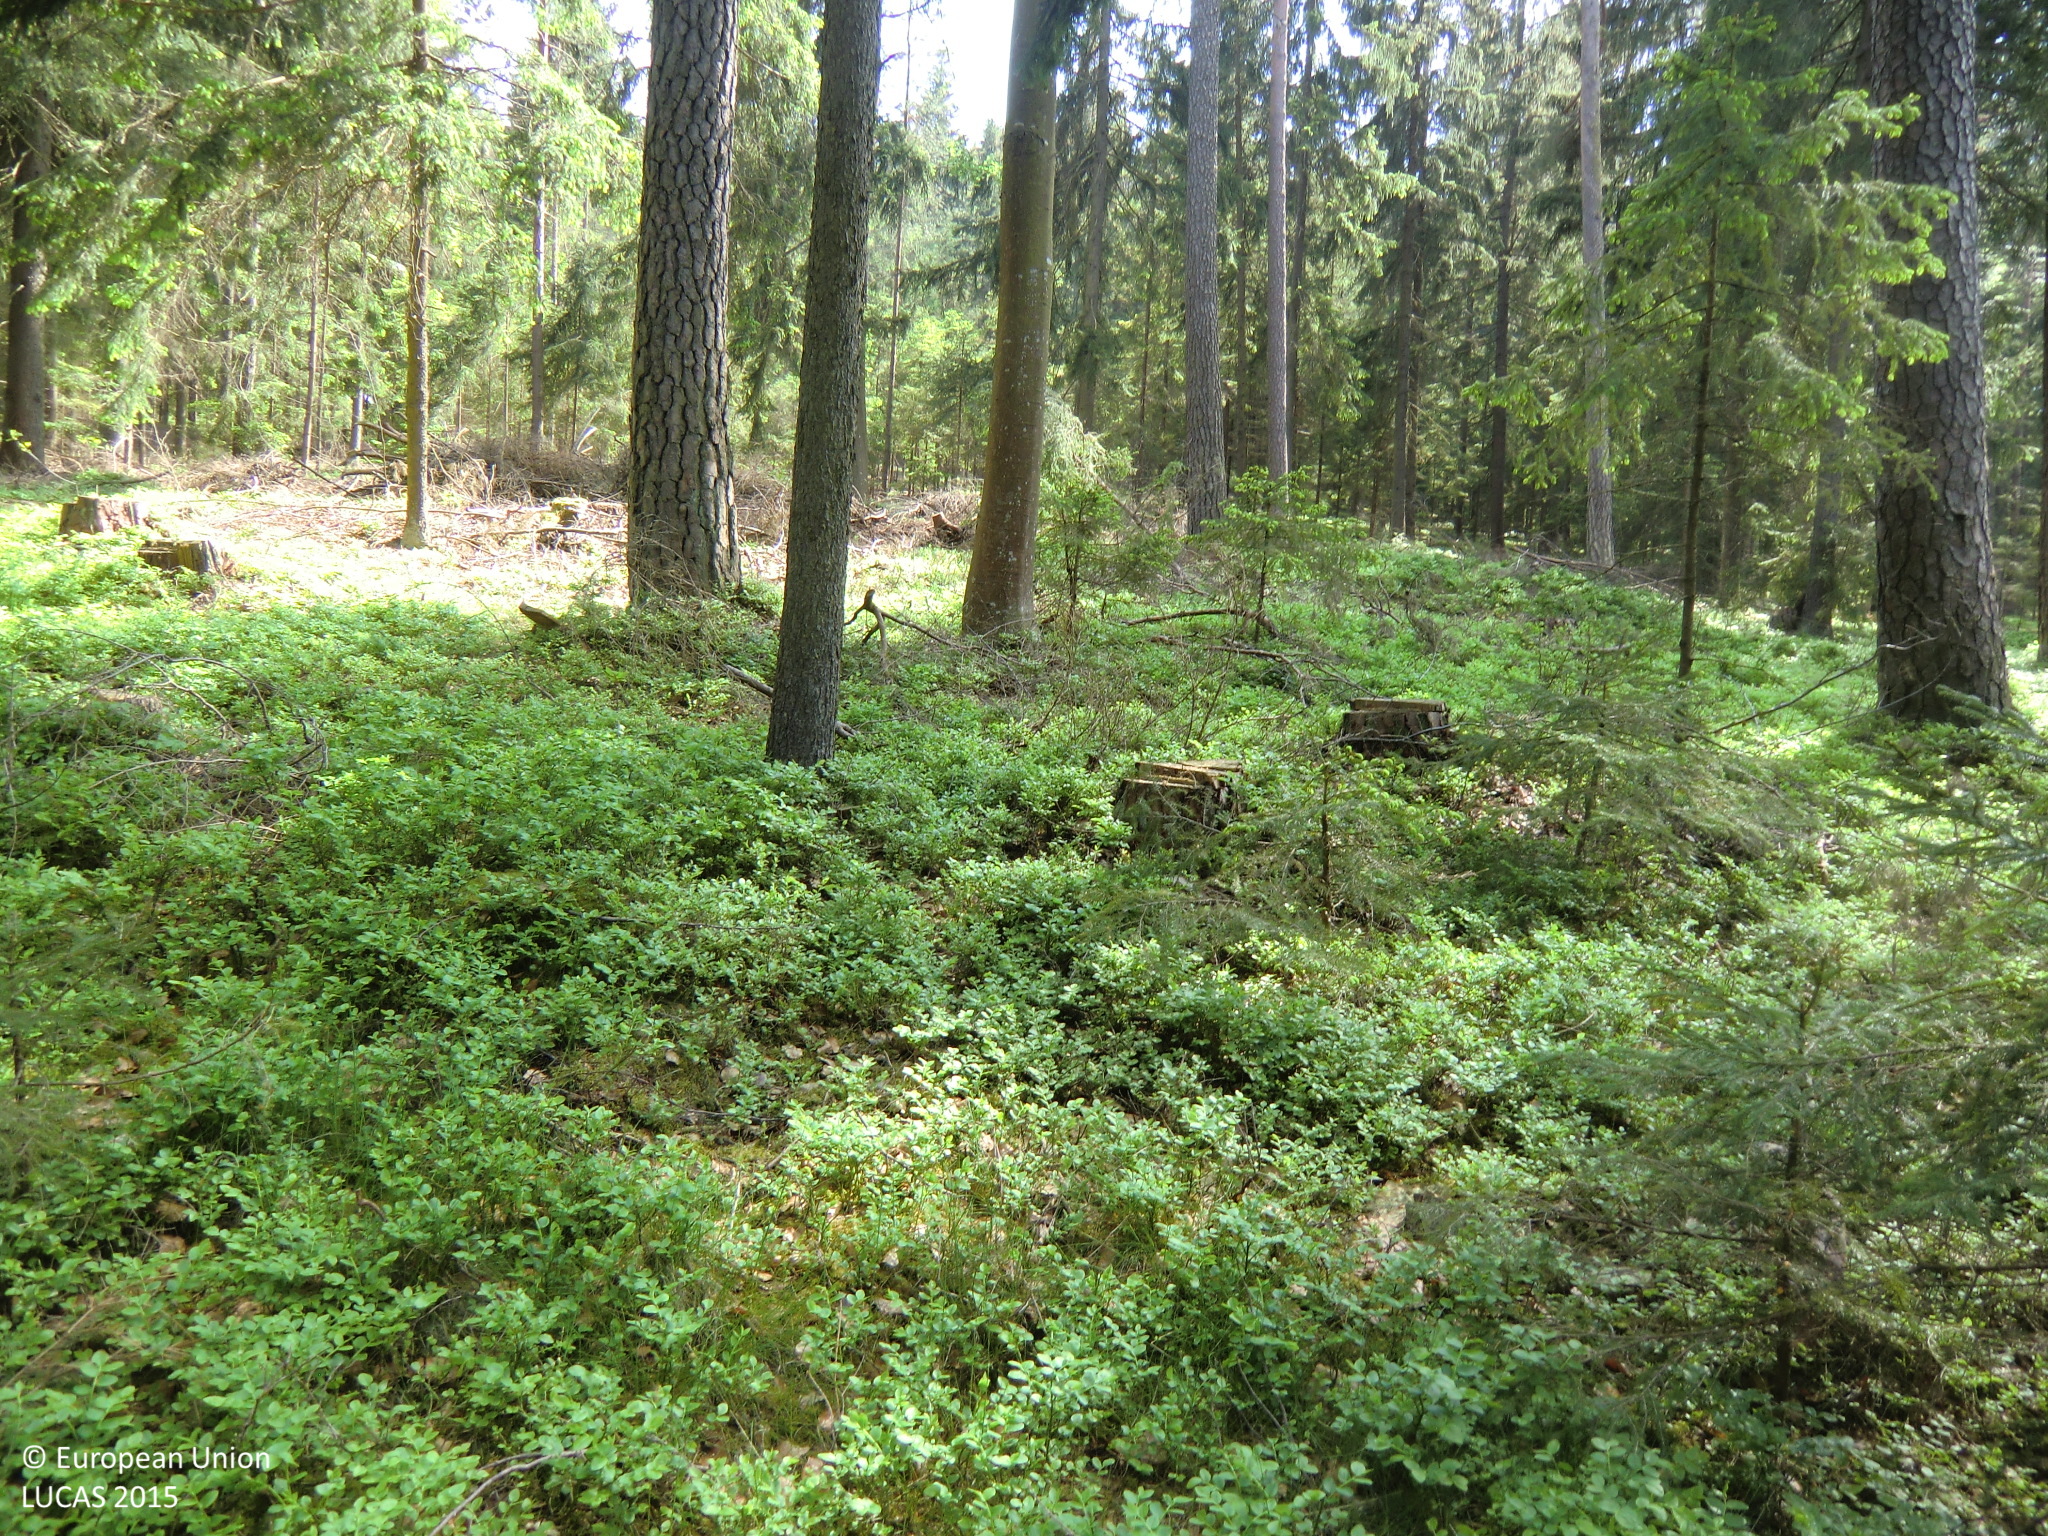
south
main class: Woodland
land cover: Pine dominated coniferous woodland
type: hemiboreal forest and nemoral coniferous forest and mixed broadleaved-coniferous forest
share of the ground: > 75 %
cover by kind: coniferous forest trees 60 %, shrubs 30 %, lichens and mosses 10 %
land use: Forestry
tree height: > 5 m
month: May
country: AT
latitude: 48.4254
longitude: 14.3654
